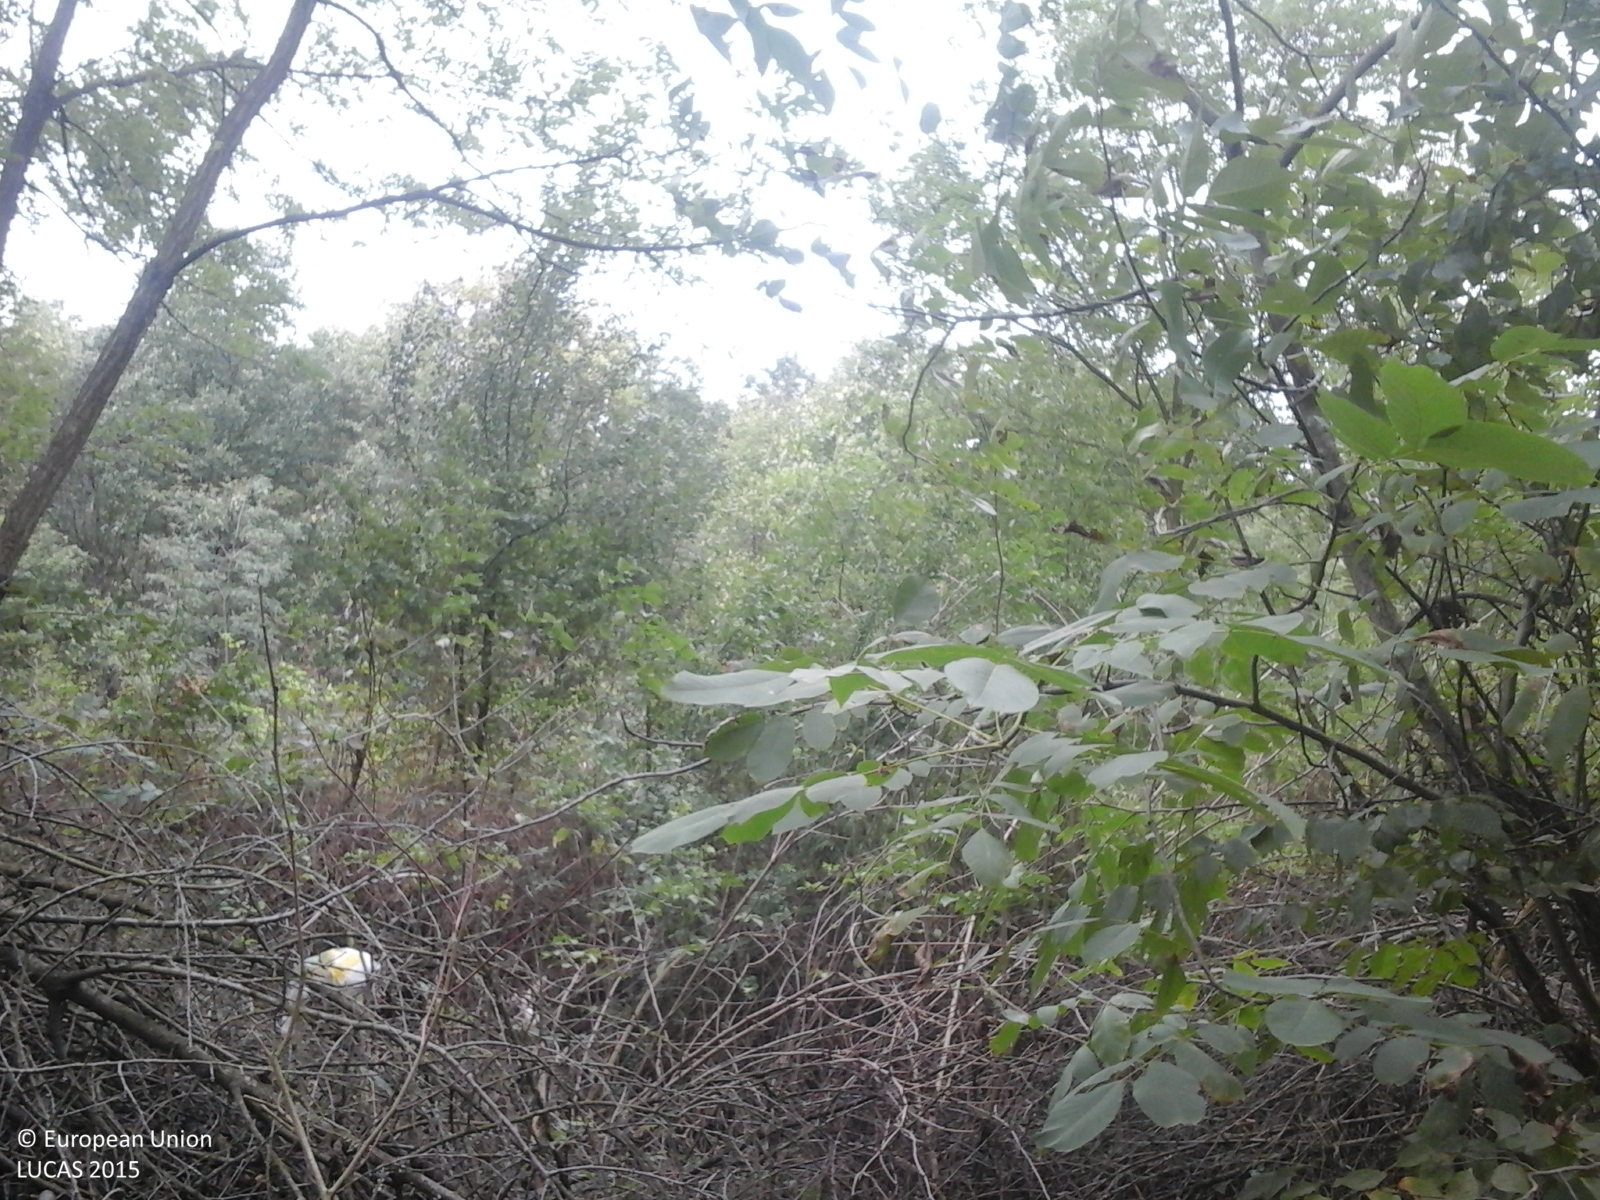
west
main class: Woodland
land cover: Broadleaved woodland
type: exotic forest
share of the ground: > 75 %
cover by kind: broadleaved forest trees 100 %
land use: Forestry
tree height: > 5 m
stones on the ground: < 10 %
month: September
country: RO
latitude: 45.8752
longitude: 23.0557
